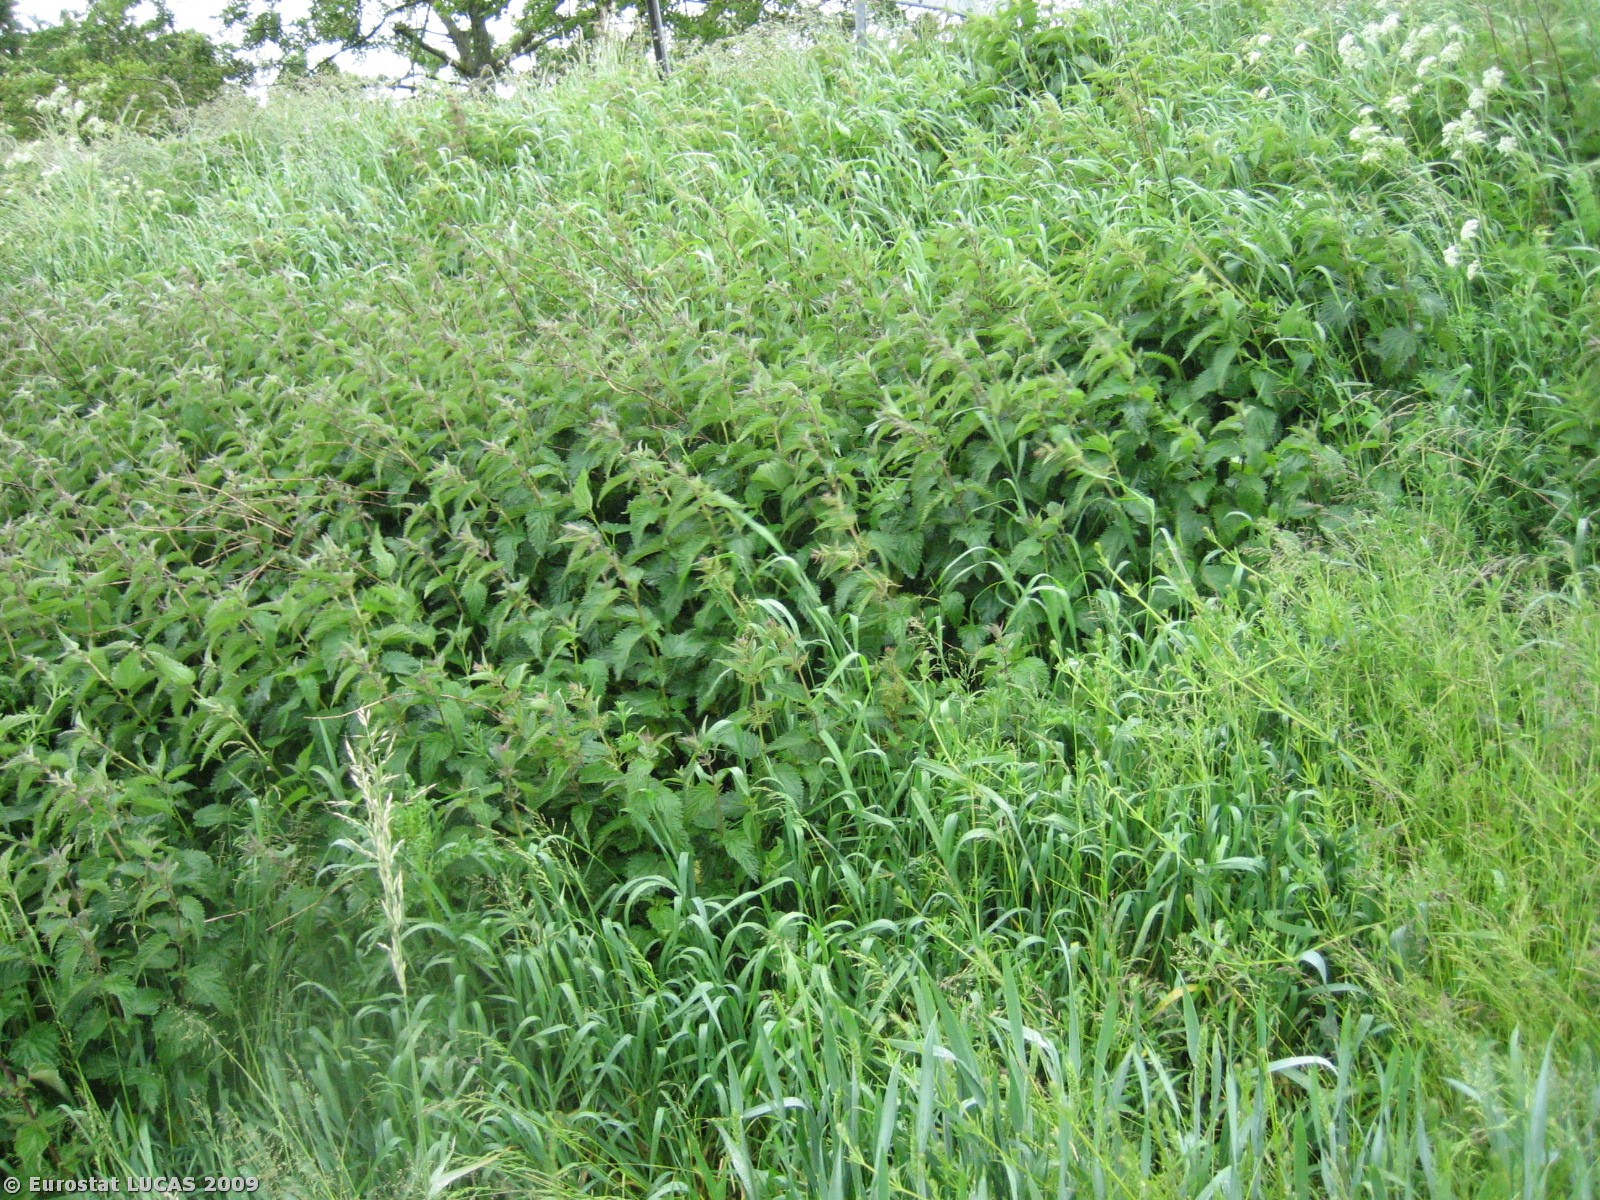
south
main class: Cropland
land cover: Common wheat
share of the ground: > 75 %
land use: Agriculture (excluding fallow land and kitchen gardens)
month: June
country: DK
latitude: 56.0079
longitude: 10.1442
